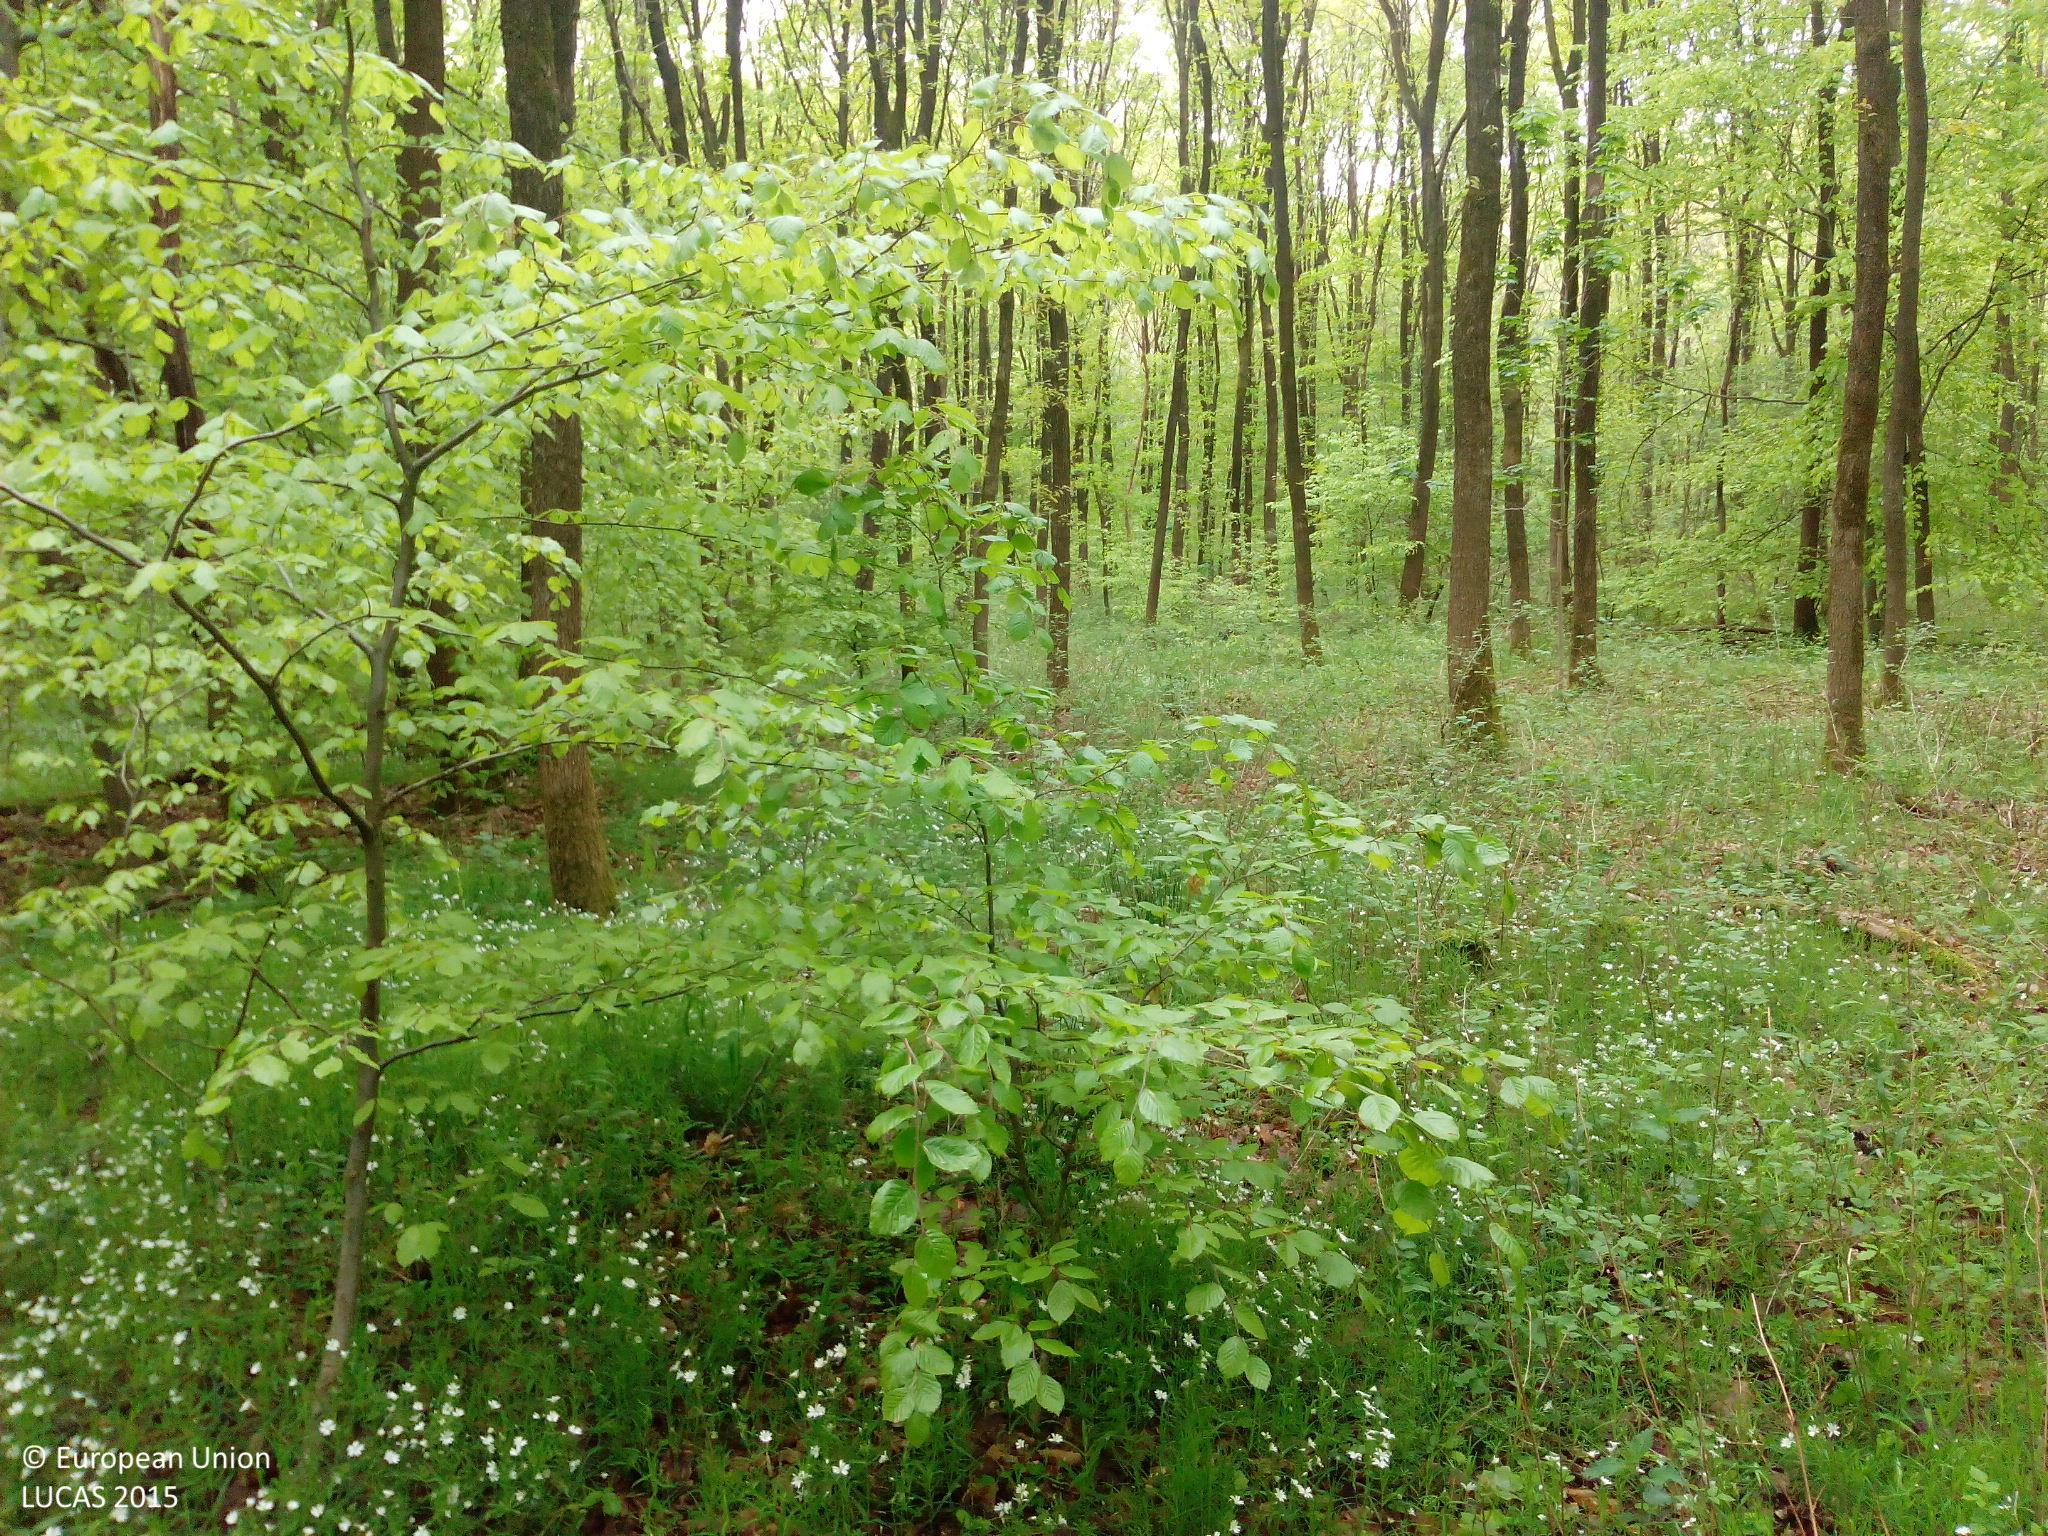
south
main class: Woodland
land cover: Broadleaved woodland
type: acidophilous oak and oak-birch forest
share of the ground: > 75 %
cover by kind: broadleaved forest trees 90 %, shrubs 10 %
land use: Forestry
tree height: > 5 m
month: May
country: DE
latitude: 53.2727
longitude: 9.0857
